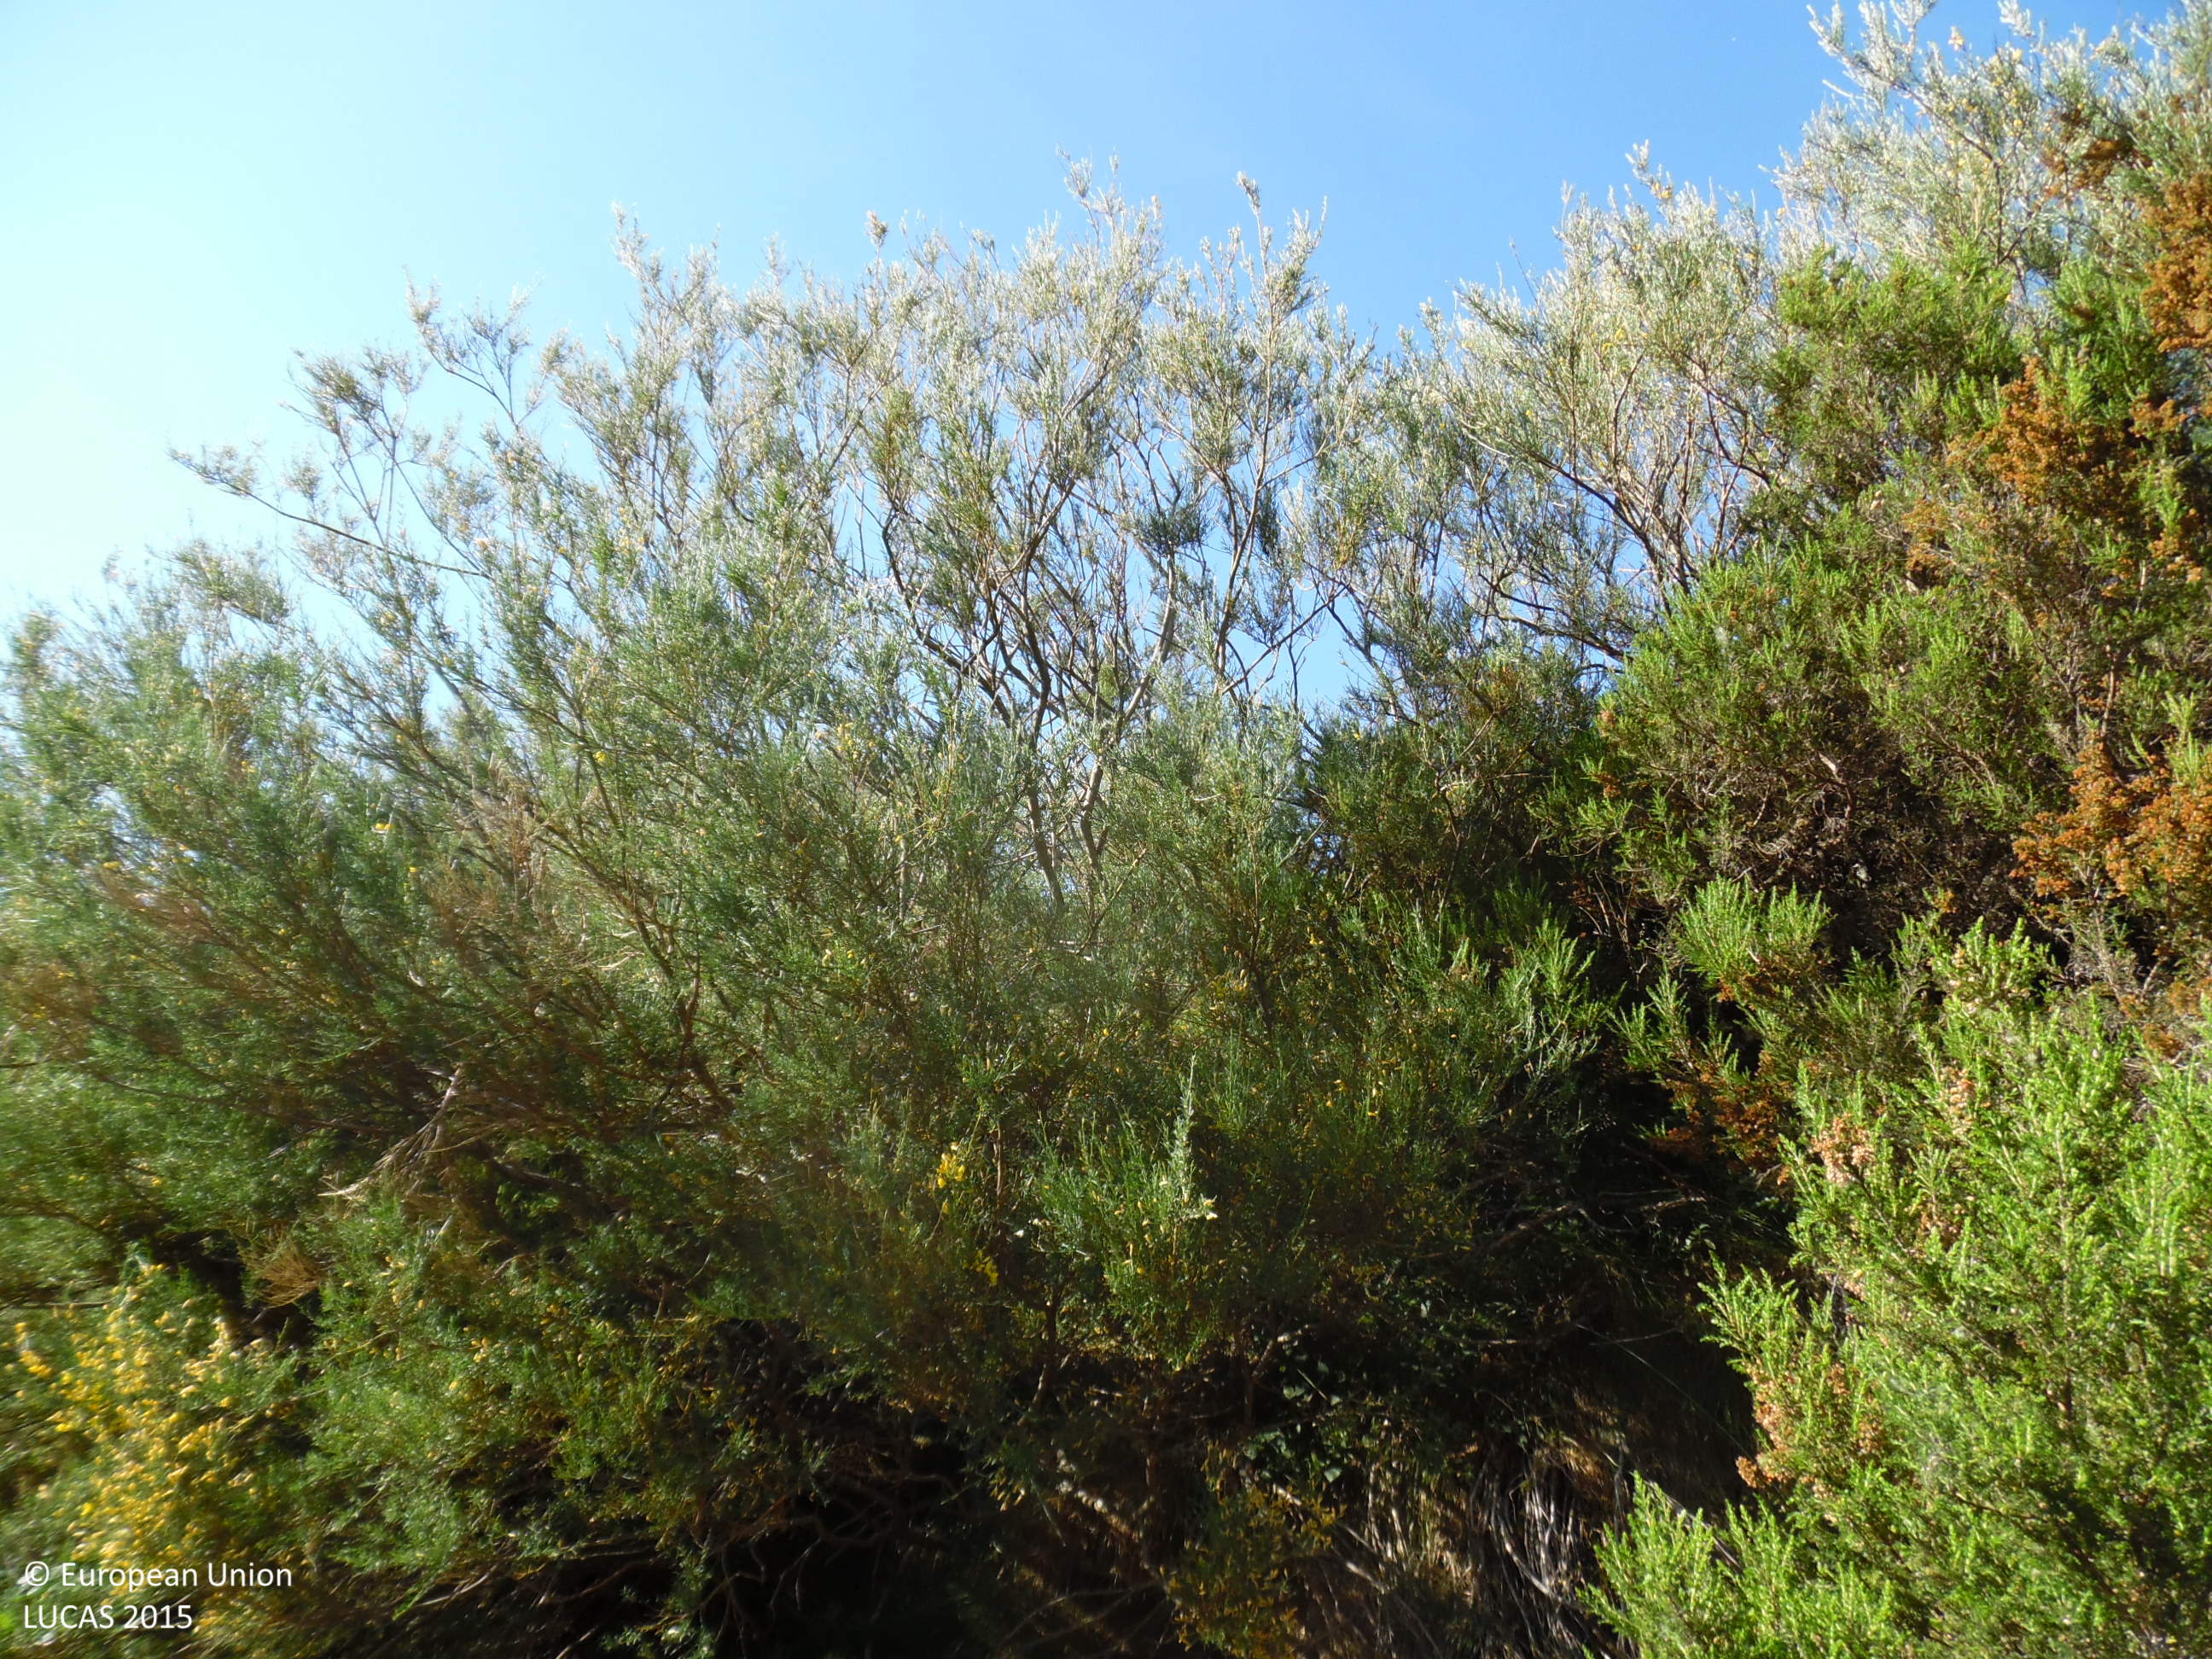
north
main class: Shrubland
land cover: Shrubland without tree cover
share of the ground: > 75 %
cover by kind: shrubs 100 %
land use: Abandoned areas
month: July
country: ES
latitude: 42.9810
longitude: -5.4650
